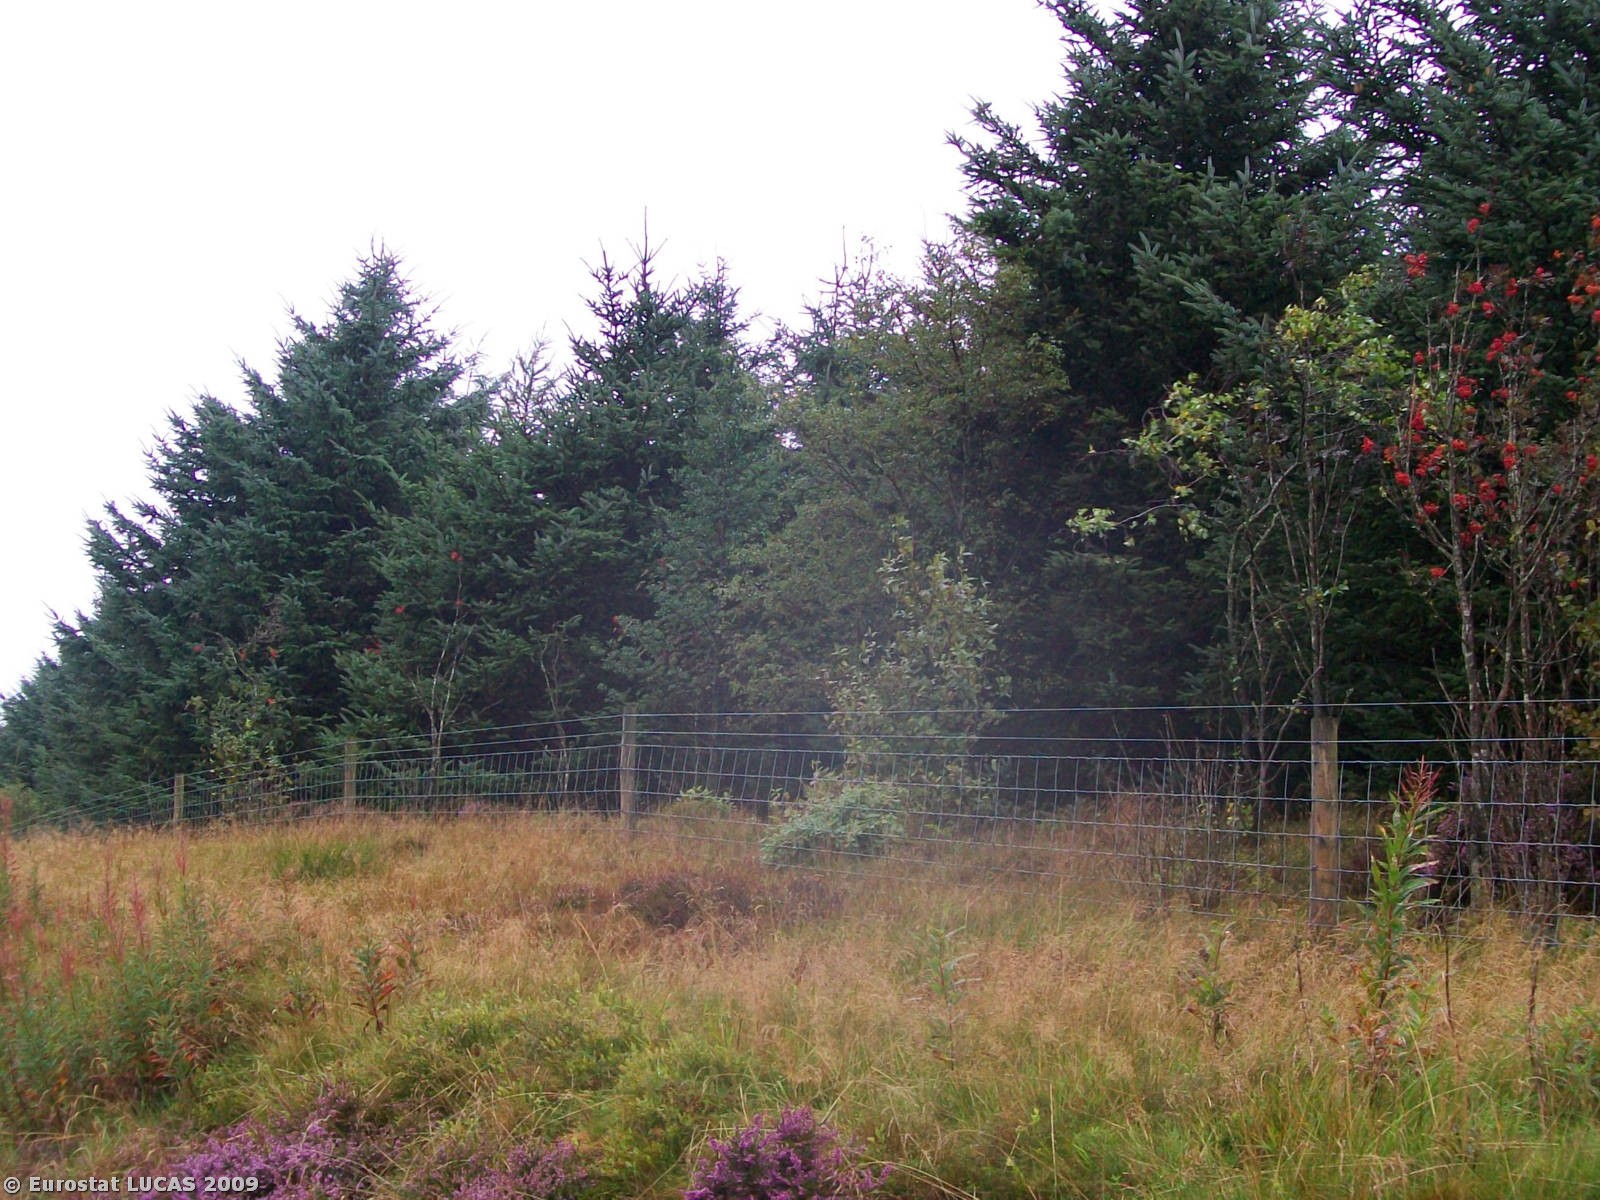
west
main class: Woodland
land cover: Coniferous woodland
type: plantations and self-sown exotic forest
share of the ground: > 75 %
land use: Forestry
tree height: > 5 m
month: August
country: GB
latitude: 54.3382
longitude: -3.1648
